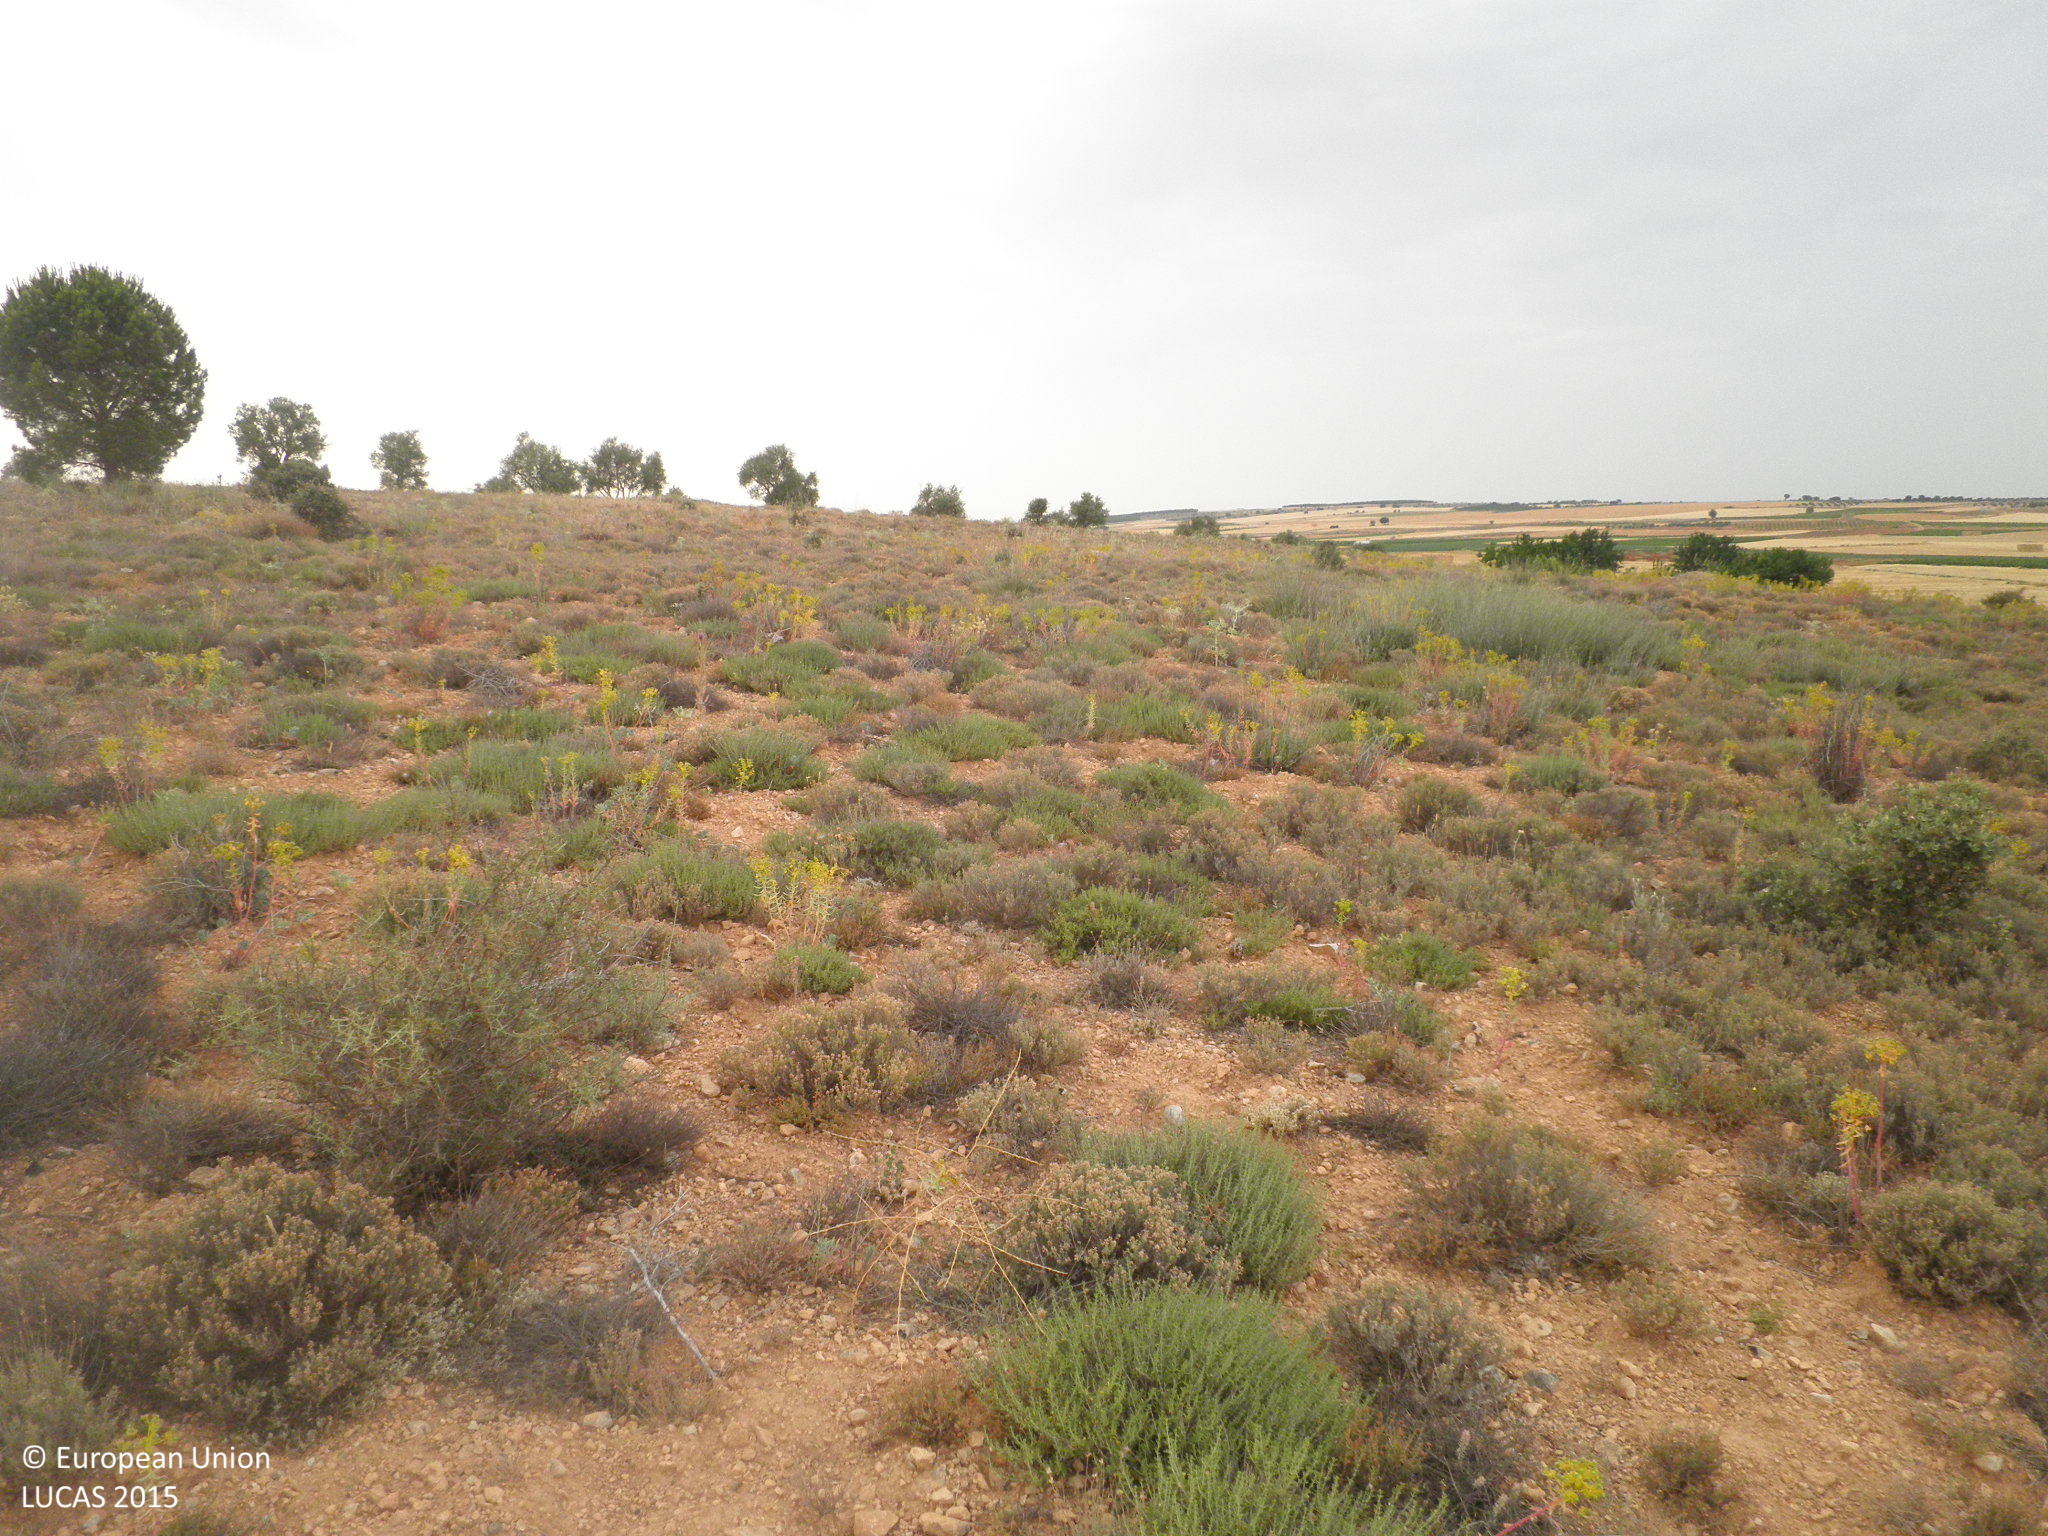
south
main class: Shrubland
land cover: Shrubland without tree cover
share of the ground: 50 - 75 %
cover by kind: shrubs 60 %, unconsolidated bare surface 35 %, herbaceous plants 5 %
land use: Semi-natural and natural areas not in use
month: July
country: ES
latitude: 39.5053
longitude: -2.6083
